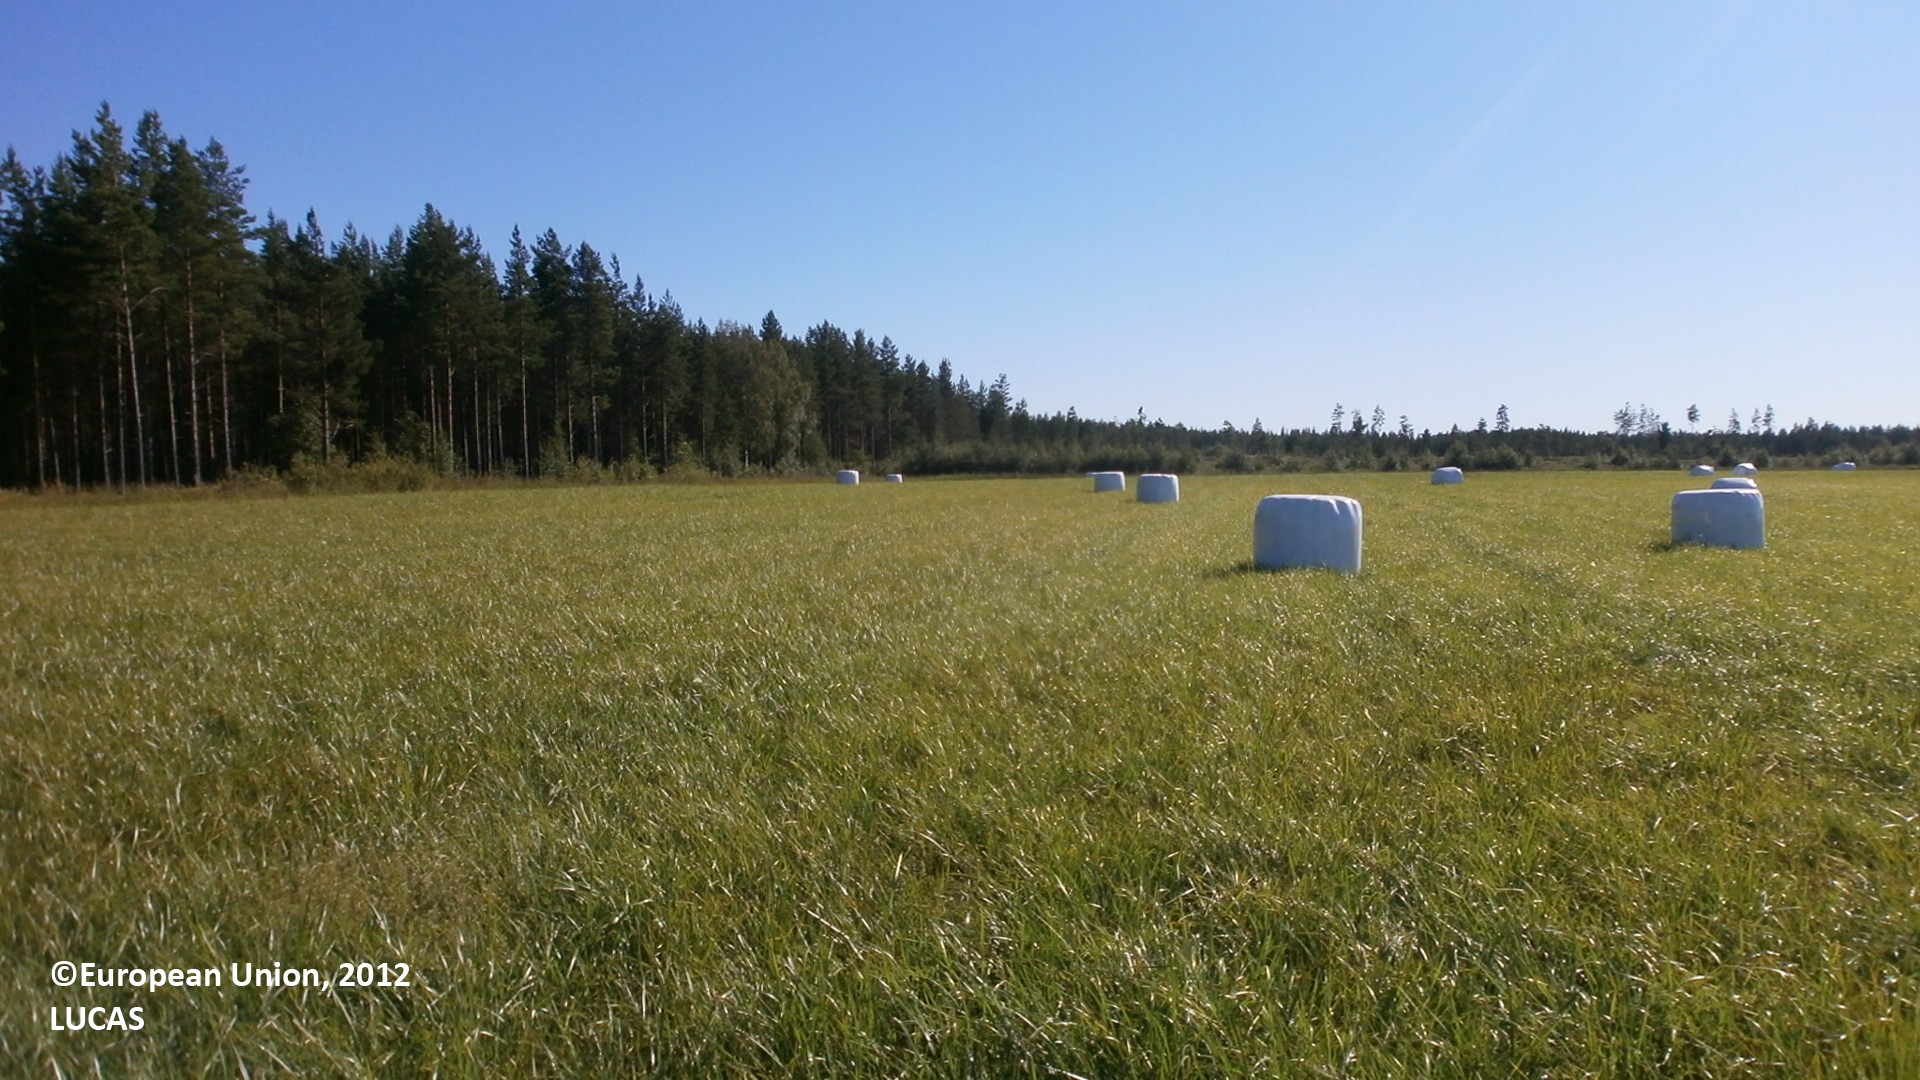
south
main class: Cropland
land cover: Temporary grasslands
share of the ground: > 75 %
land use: Agriculture (excluding fallow land and kitchen gardens)
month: July
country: FI
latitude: 64.1649
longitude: 23.9455
